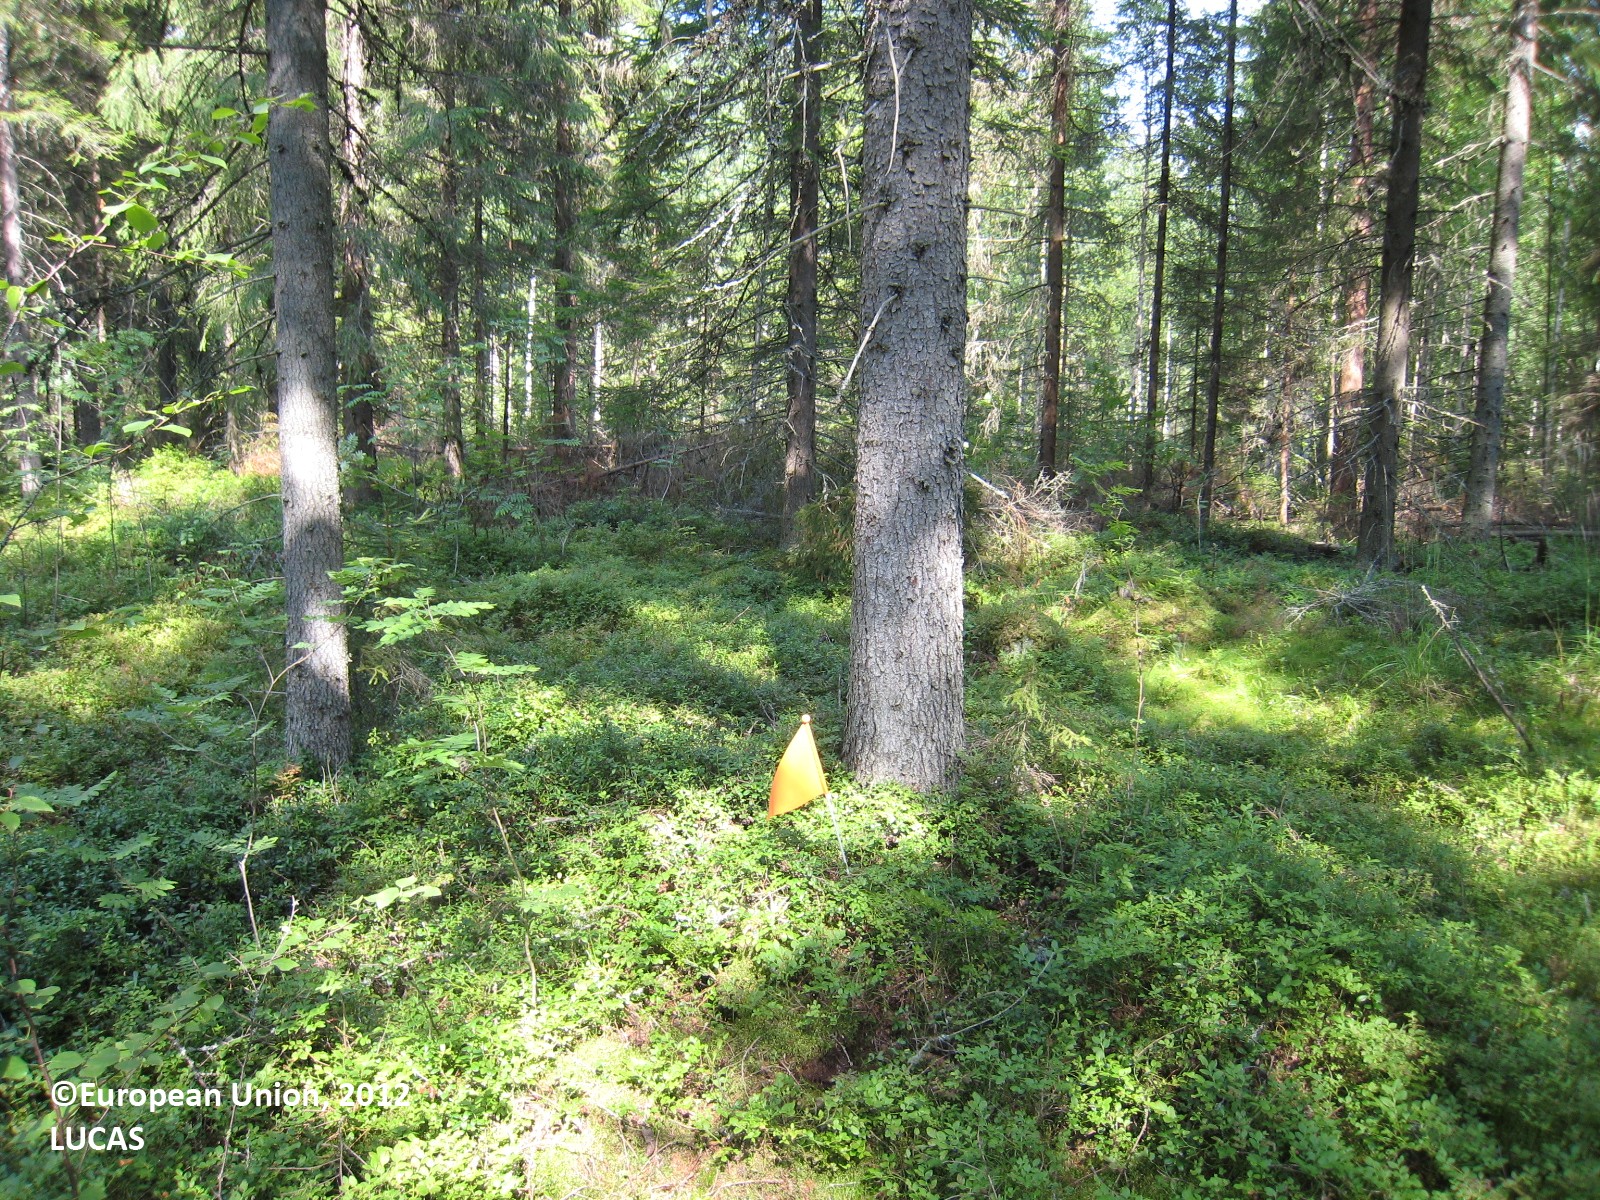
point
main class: Woodland
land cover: Spruce dominated coniferous woodland
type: boreal forest
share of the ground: 50 - 75 %
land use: Forestry
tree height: > 5 m
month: July
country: FI
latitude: 61.7901
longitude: 26.1205
